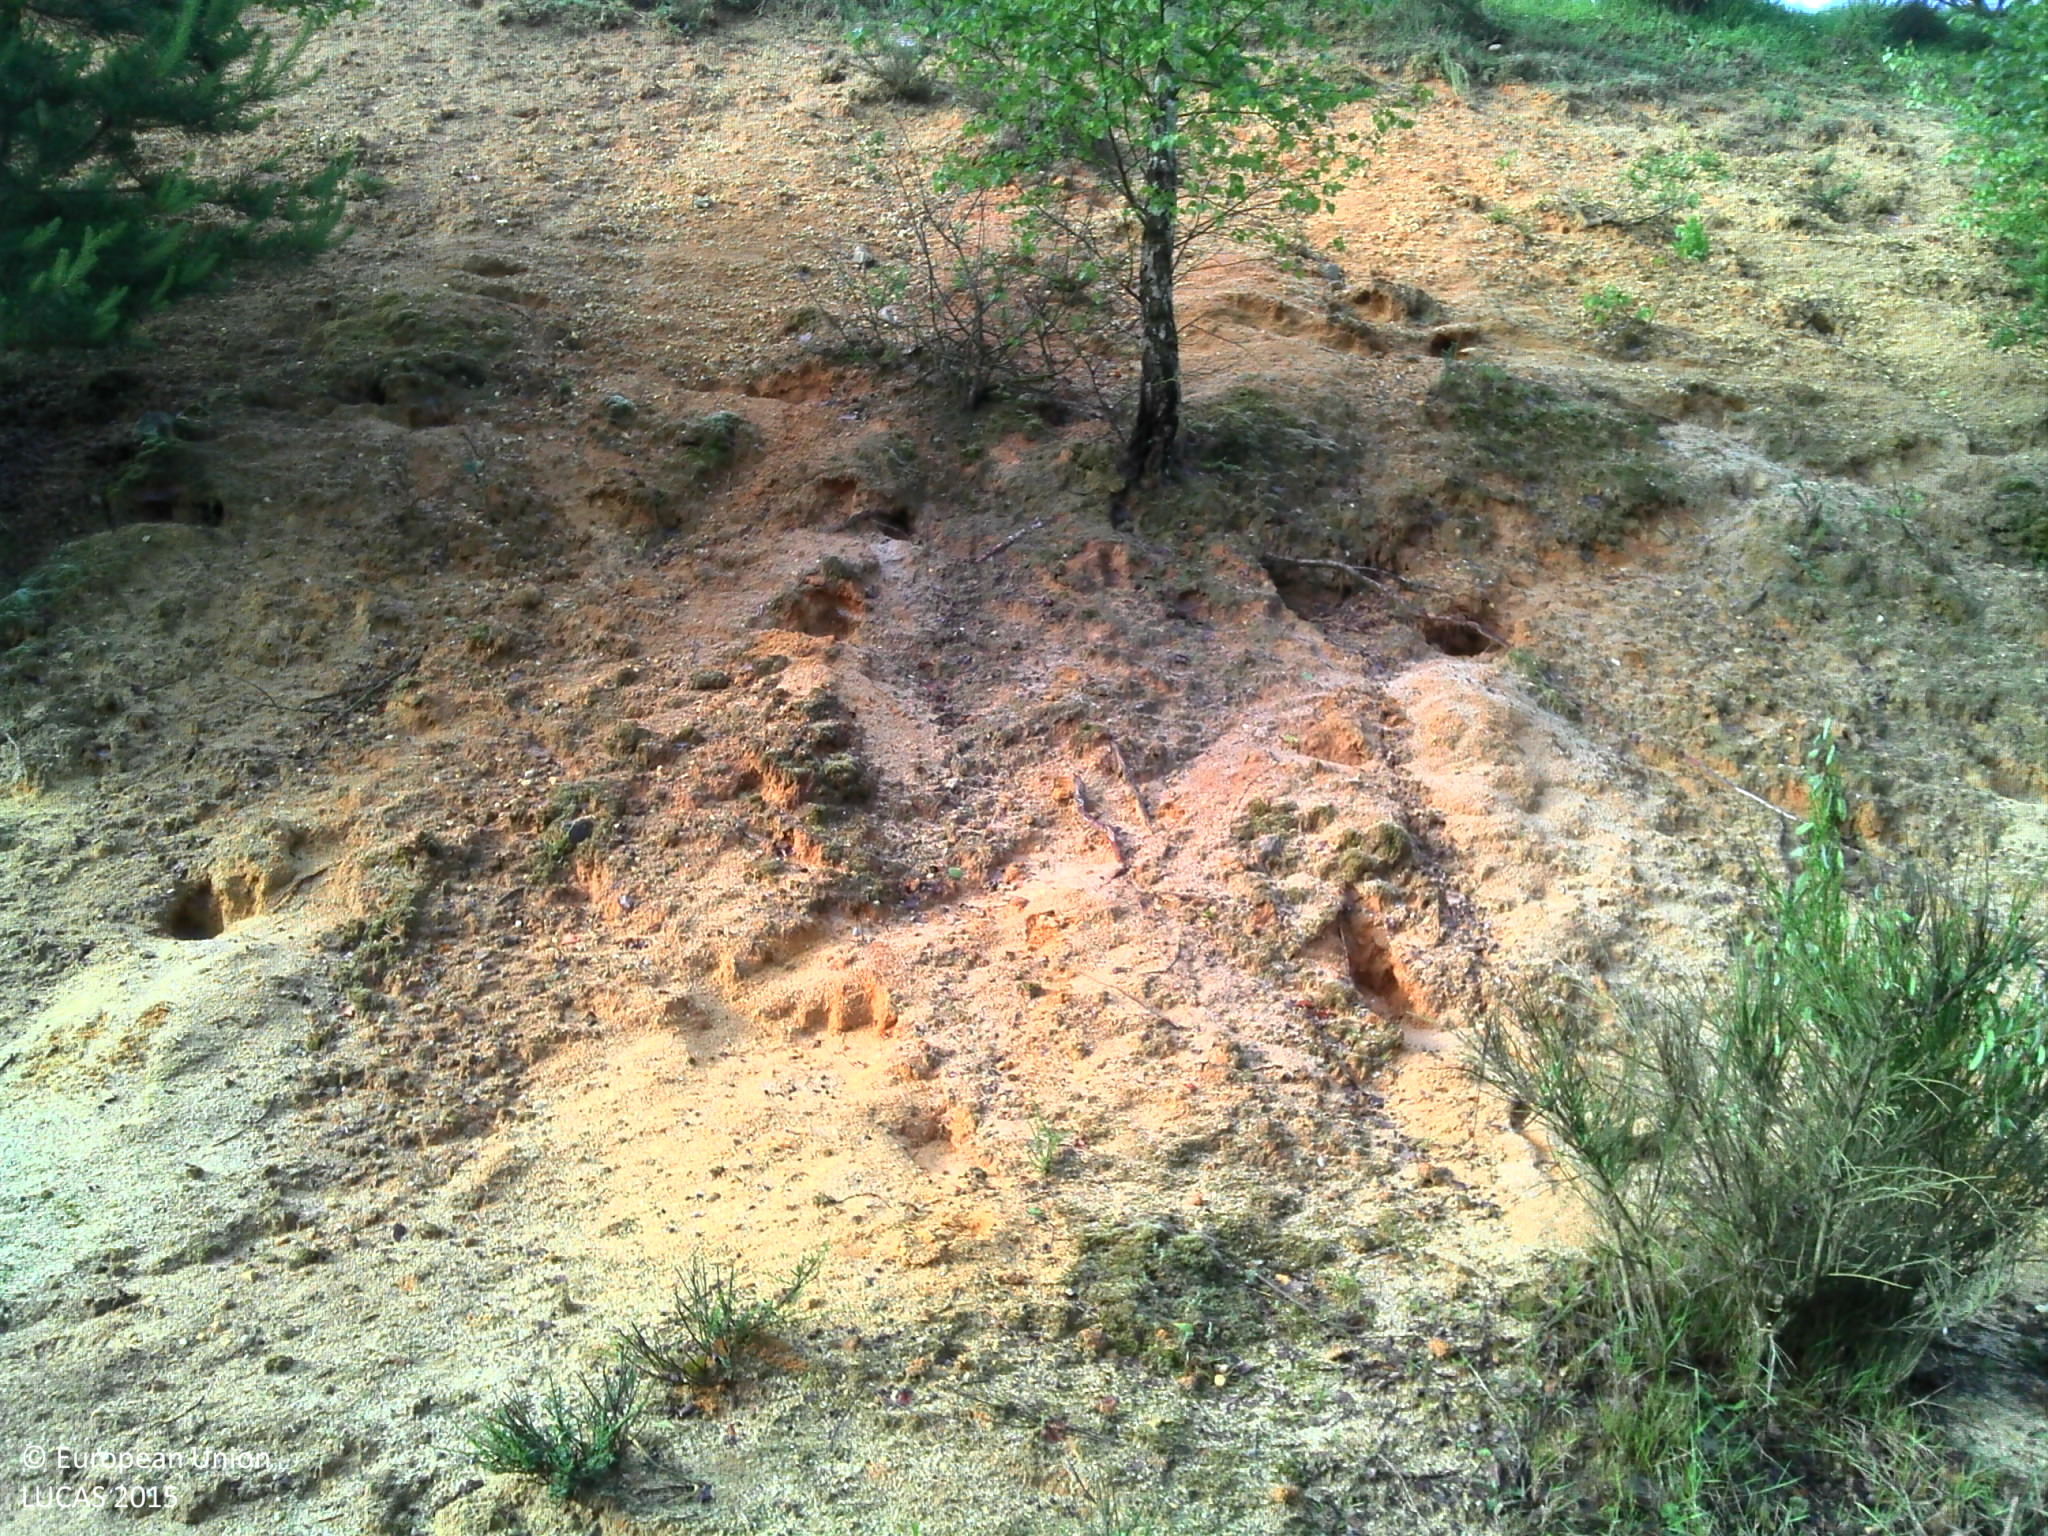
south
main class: Woodland
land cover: Broadleaved woodland
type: exotic forest
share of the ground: > 75 %
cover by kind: broadleaved forest trees 90 %, herbaceous plants 5 %, lichens and mosses 5 %
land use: Forestry
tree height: > 5 m
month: June
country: FR
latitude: 48.2425
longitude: -1.4509
